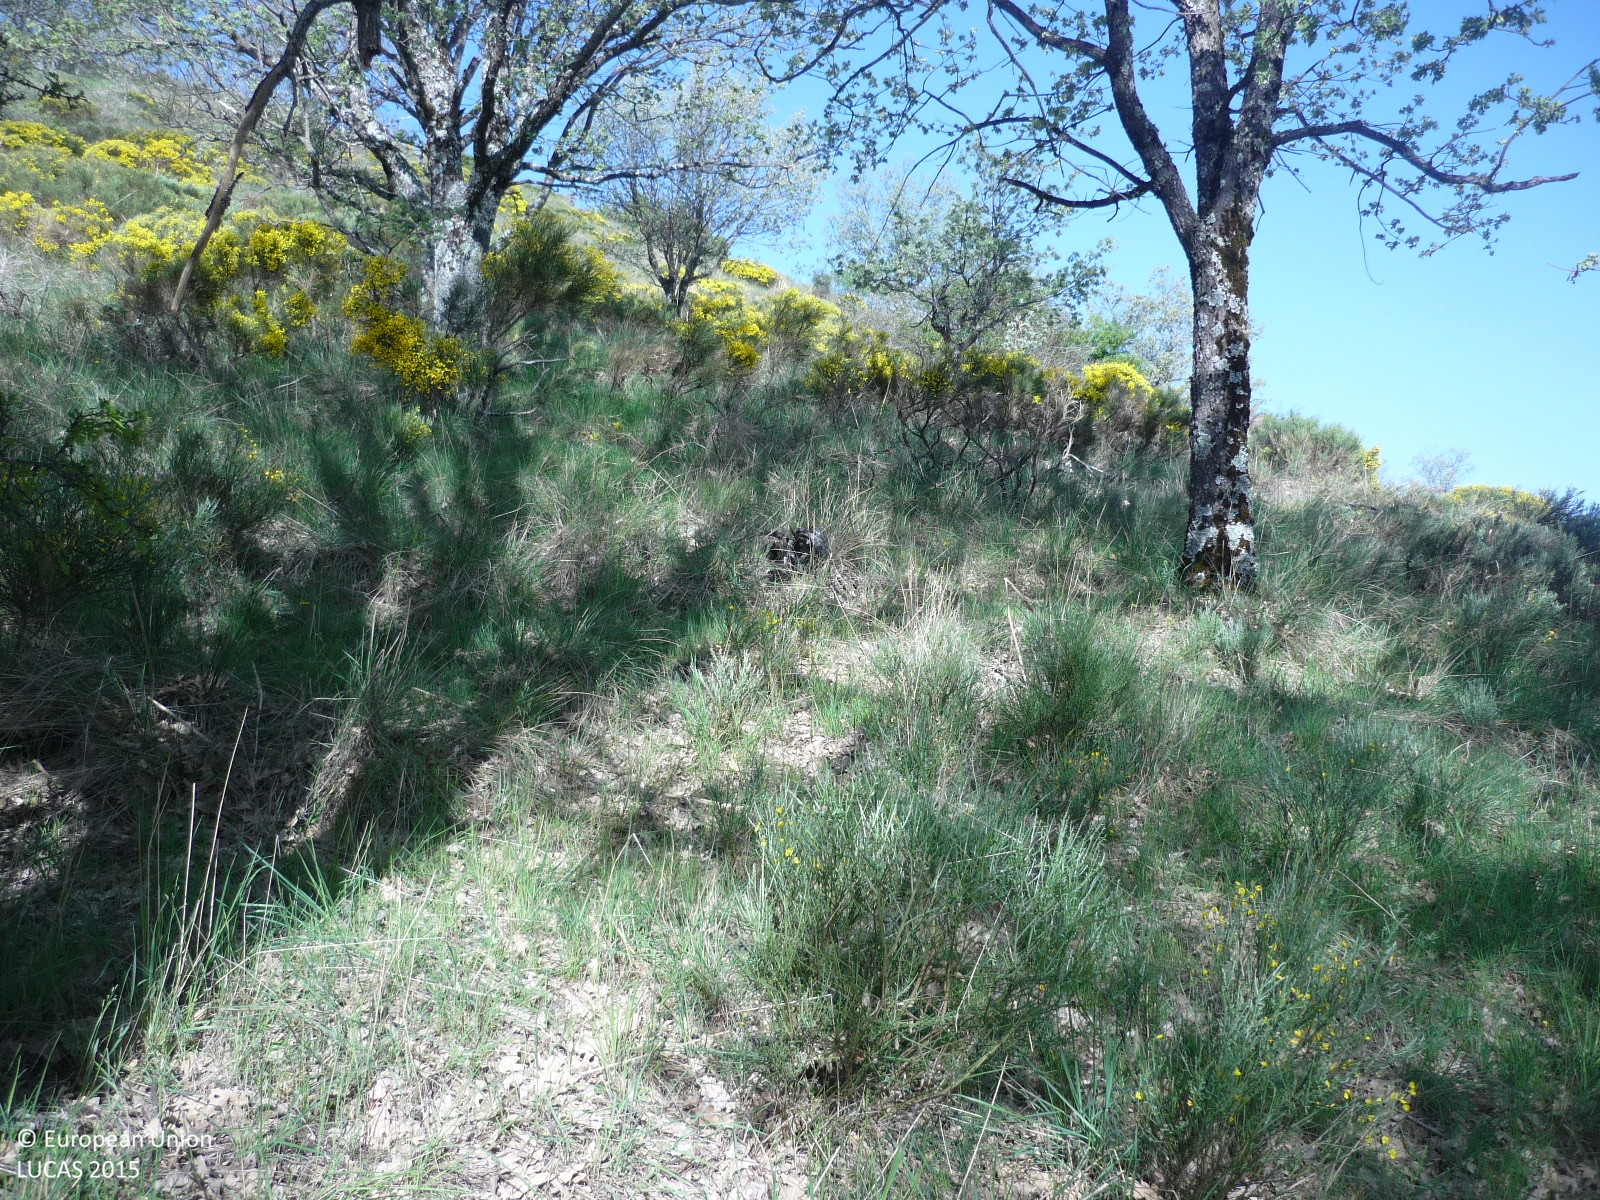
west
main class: Woodland
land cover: Broadleaved woodland
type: thermophilous deciduous forest
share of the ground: > 75 %
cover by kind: broadleaved forest trees 85 %, shrubs 10 %, herbaceous plants 5 %
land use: Semi-natural and natural areas not in use
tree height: > 5 m
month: May
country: ES
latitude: 40.8743
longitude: -3.8455
